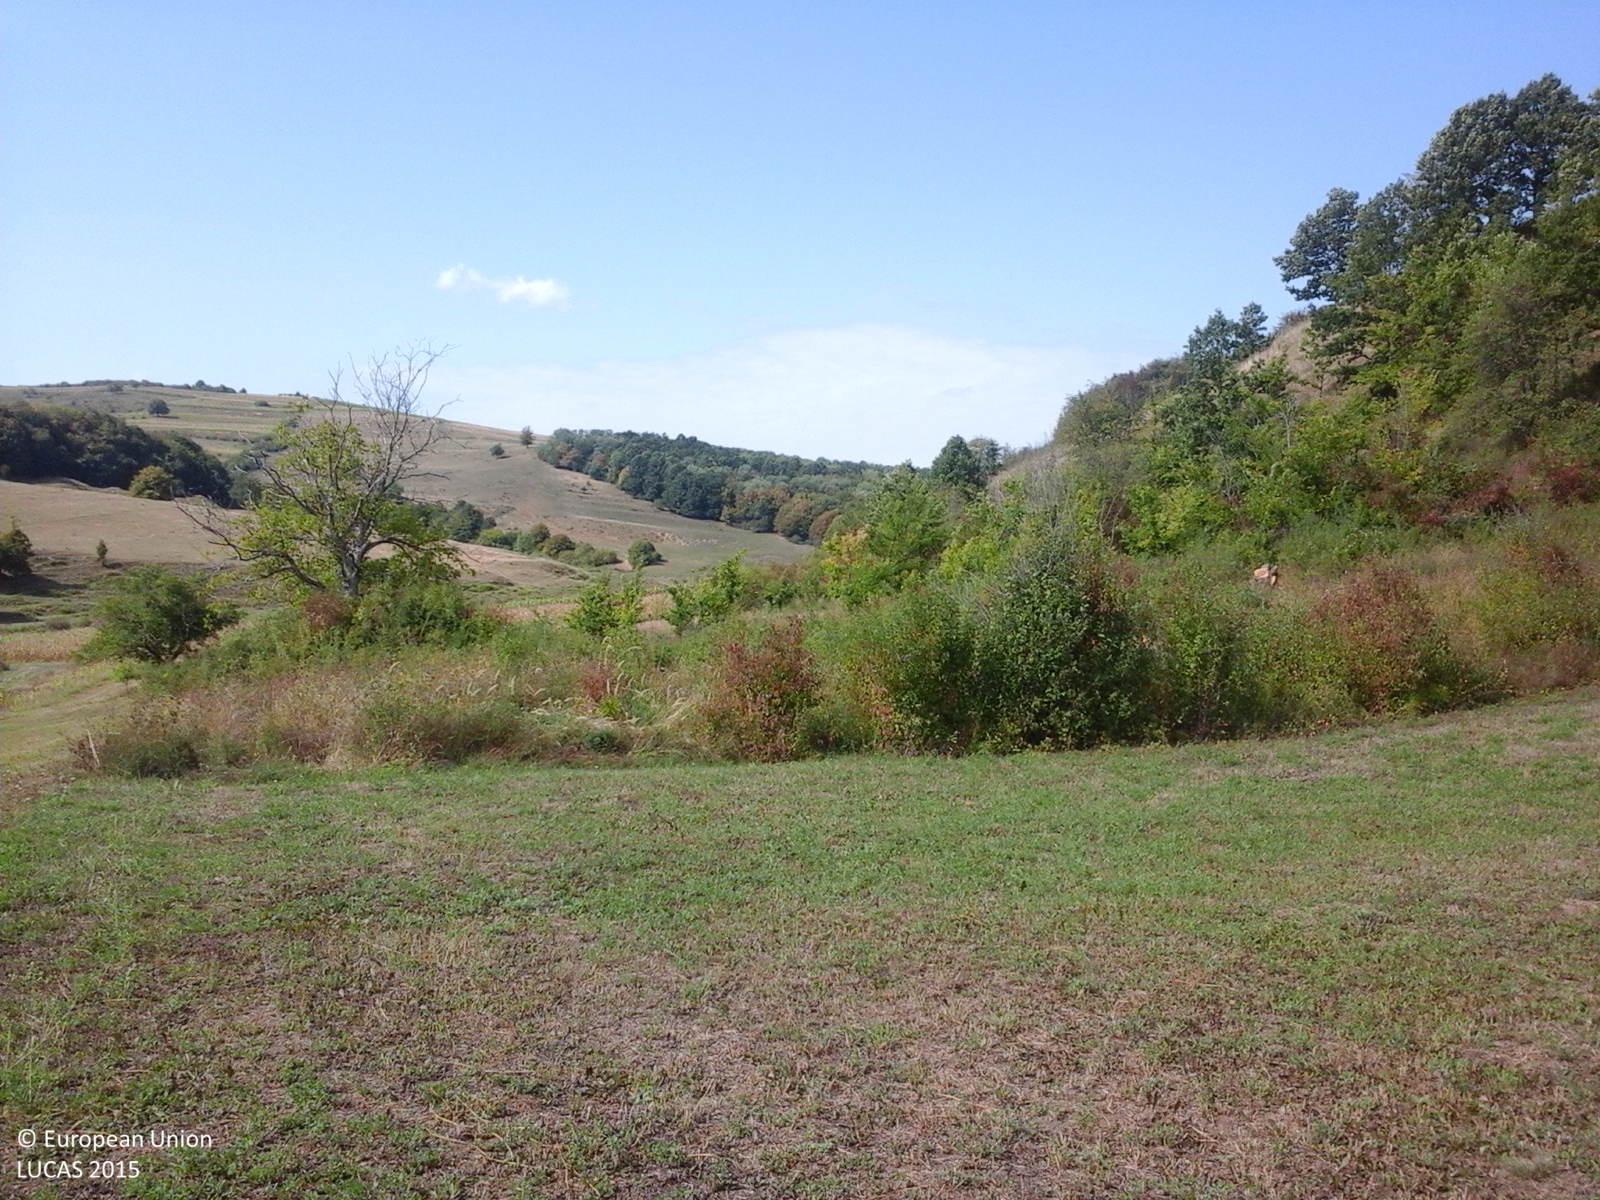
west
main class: Cropland
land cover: Lucerne
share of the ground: > 75 %
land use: Agriculture (excluding fallow land and kitchen gardens)
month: September
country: RO
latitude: 47.3510
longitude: 23.2131
